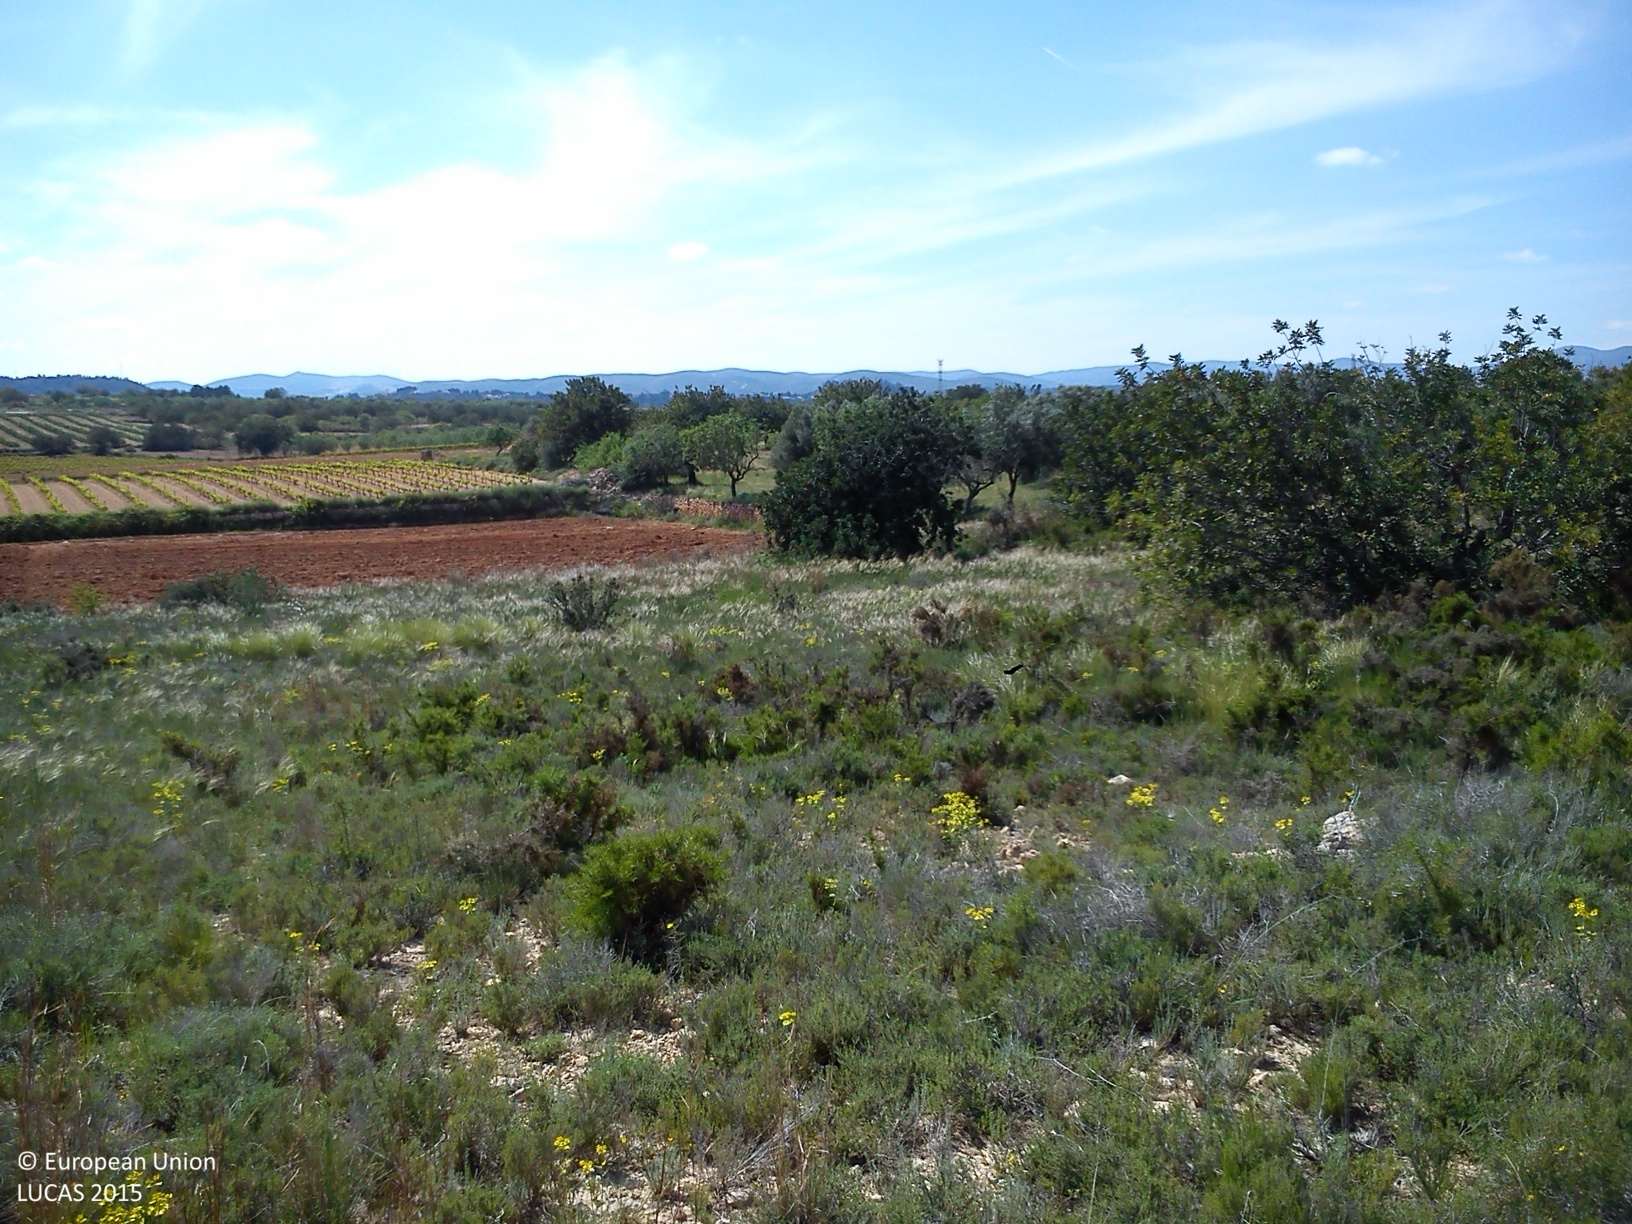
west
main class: Shrubland
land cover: Shrubland without tree cover
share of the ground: > 75 %
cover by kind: shrubs 55 %, herbaceous plants 30 %, consolidated bare surface 15 %
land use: Abandoned areas
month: April
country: ES
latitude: 39.4637
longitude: -0.6801
